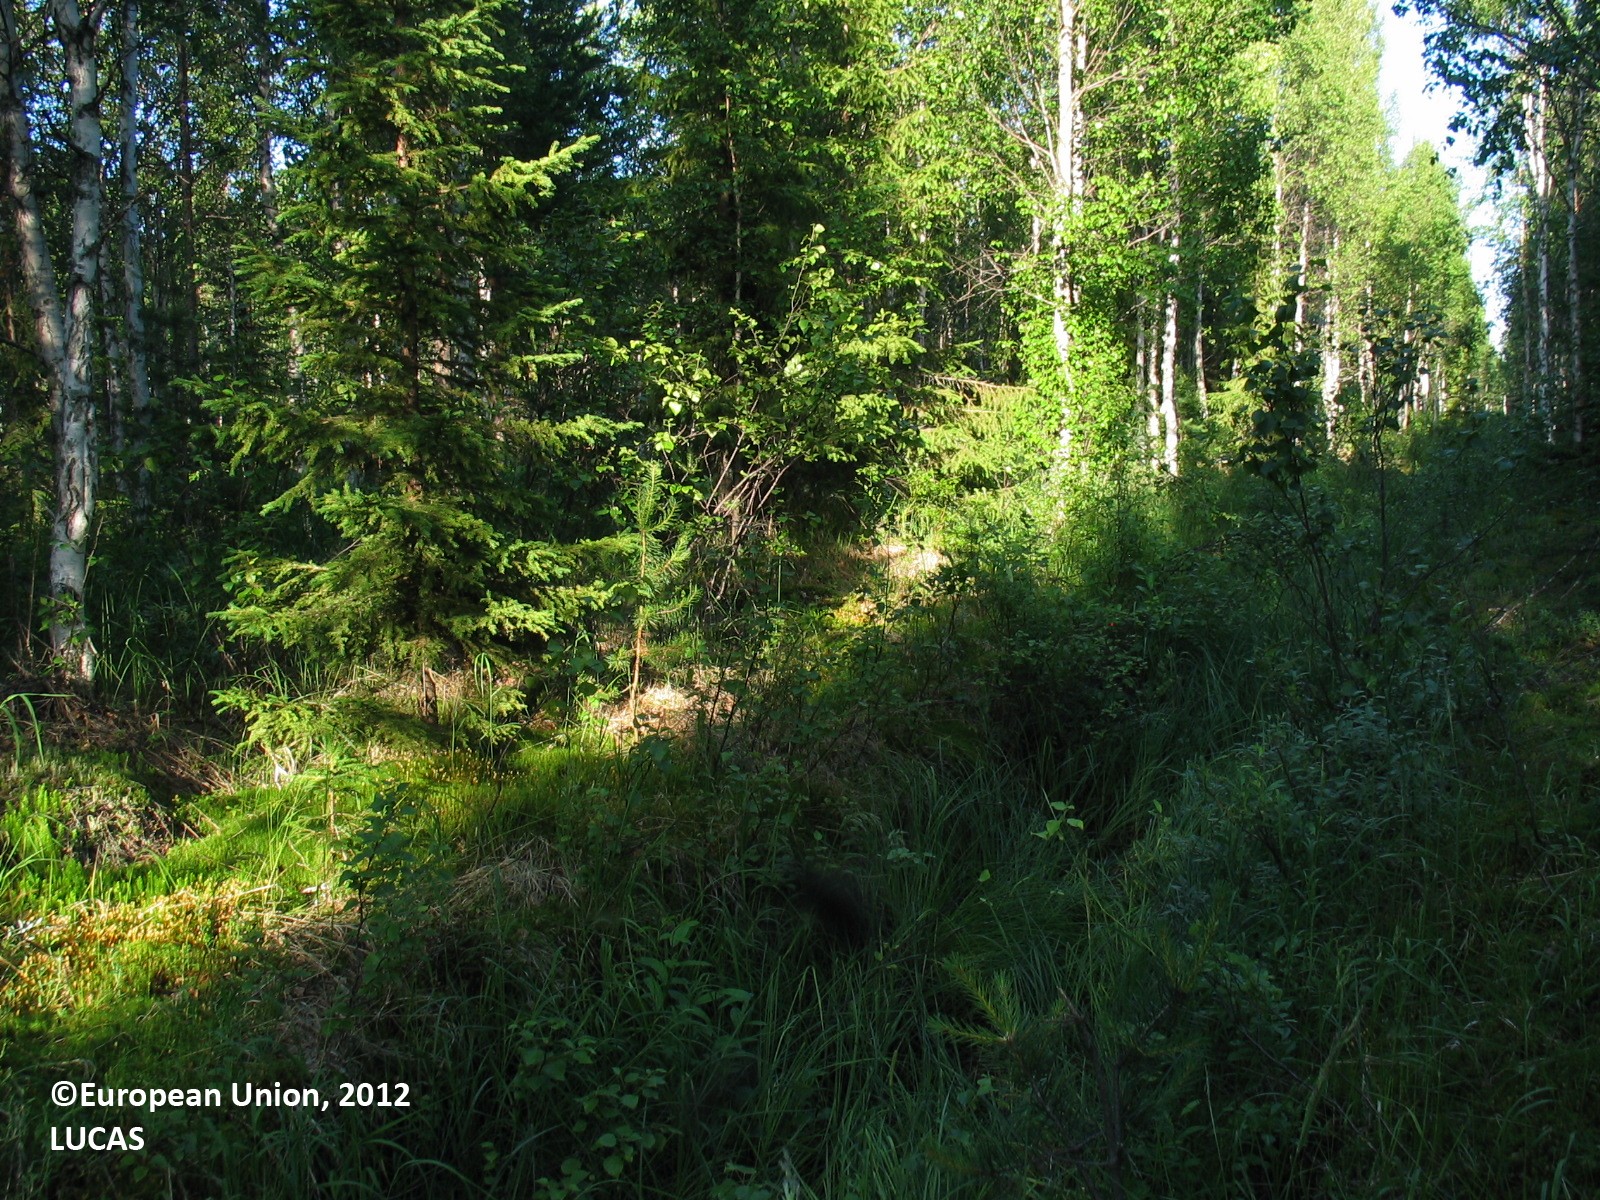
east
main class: Woodland
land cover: Broadleaved woodland
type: boreal forest
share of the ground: 25 - 50 %
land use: Forestry
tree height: > 5 m
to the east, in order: Ditches and canals; Broadleaved woodland; Ditches and canals; Broadleaved woodland; Ditches and canals; Broadleaved woodland; Pine dominated coniferous woodland
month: July
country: FI
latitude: 65.7983
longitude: 24.8602
